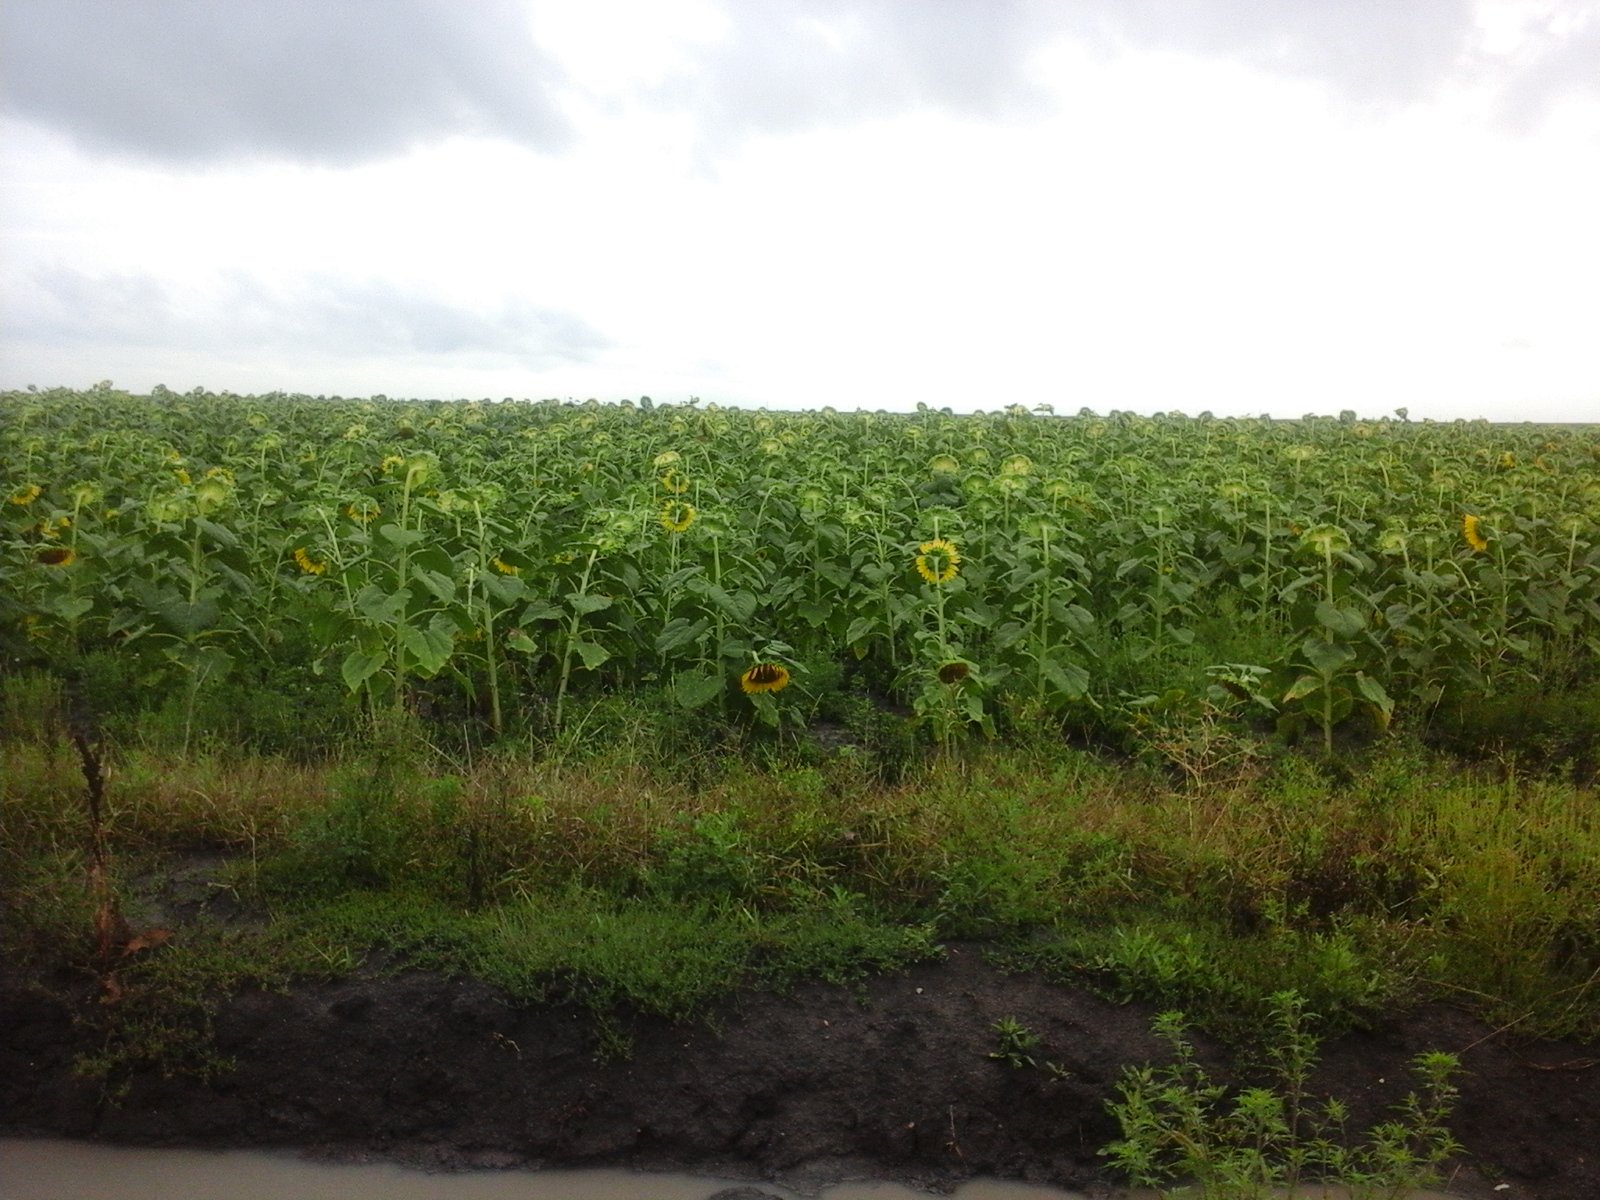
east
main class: Cropland
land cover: Sunflower
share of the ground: > 75 %
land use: Agriculture (excluding fallow land and kitchen gardens)
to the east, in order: Sunflower; Grass margins; Tracks; Grass margins; Sunflower
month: August
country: RO
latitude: 45.6021
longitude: 21.3260
